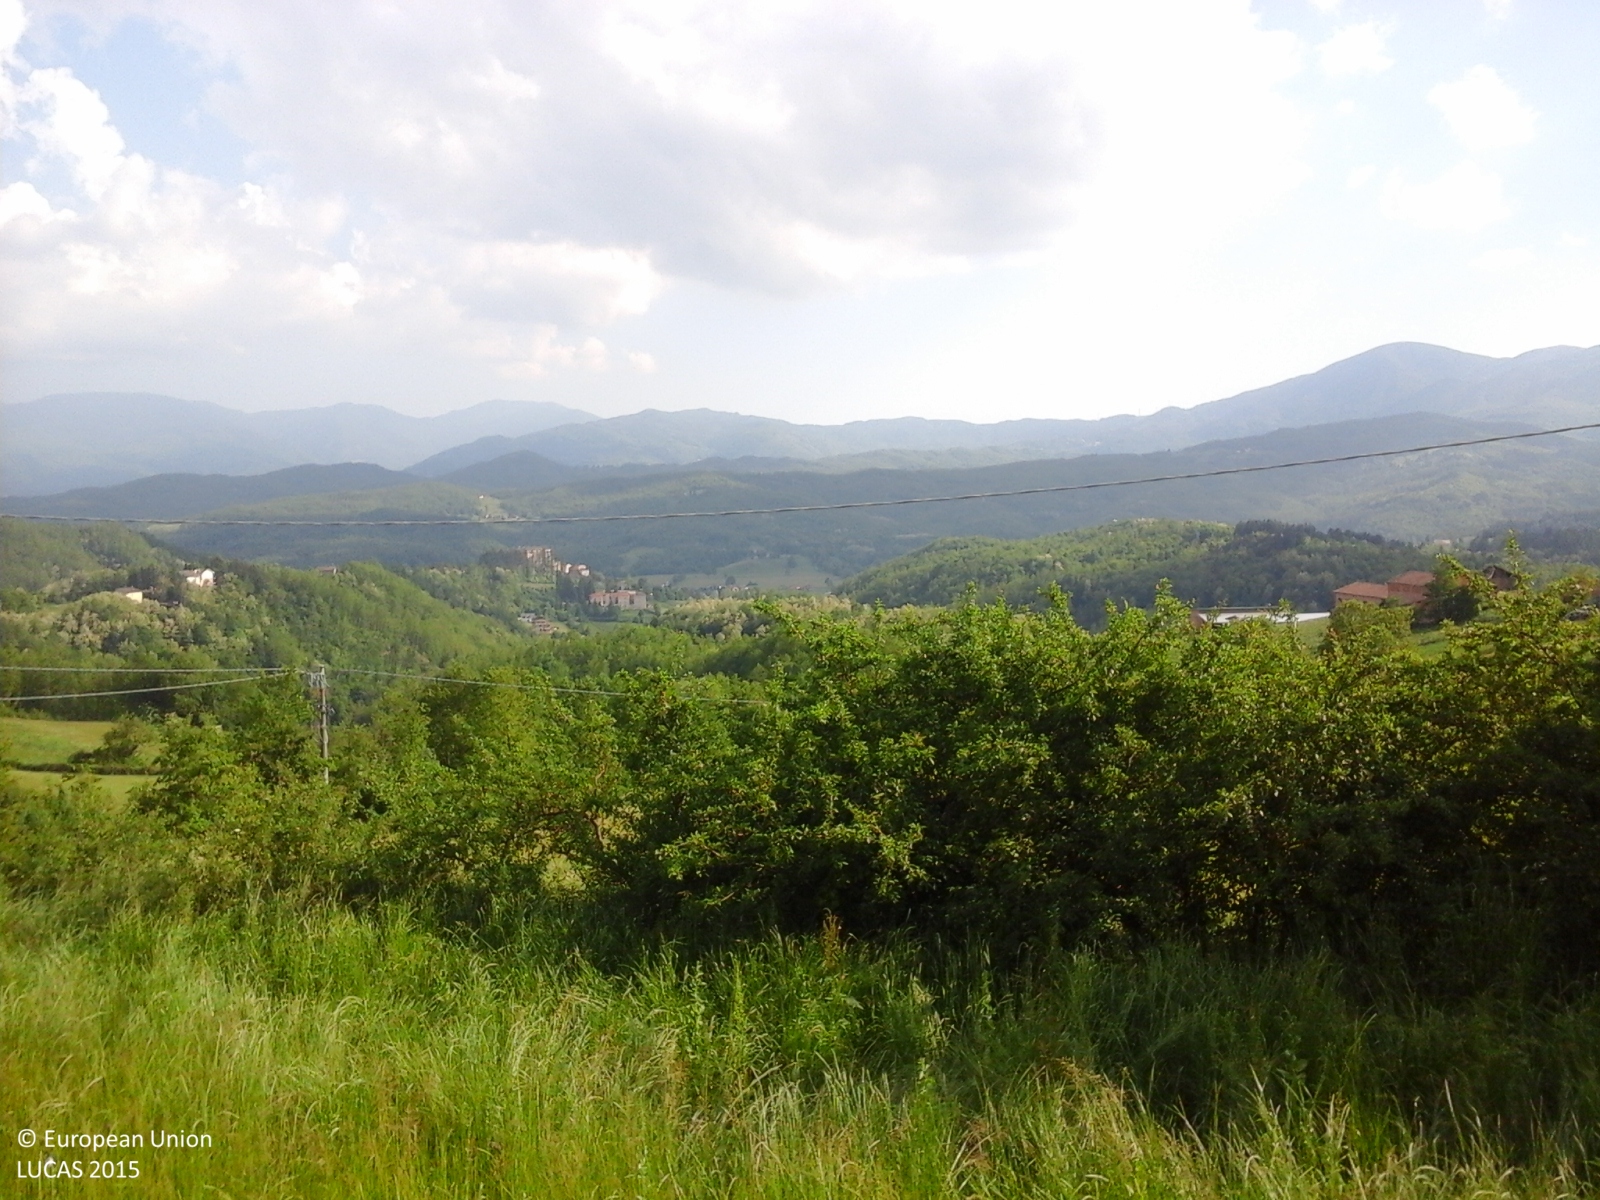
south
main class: Grassland
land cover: Spontaneously vegetated surfaces
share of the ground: > 75 %
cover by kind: herbaceous plants 100 %
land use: Agriculture (excluding fallow land and kitchen gardens)
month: May
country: IT
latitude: 44.5123
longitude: 9.6611
